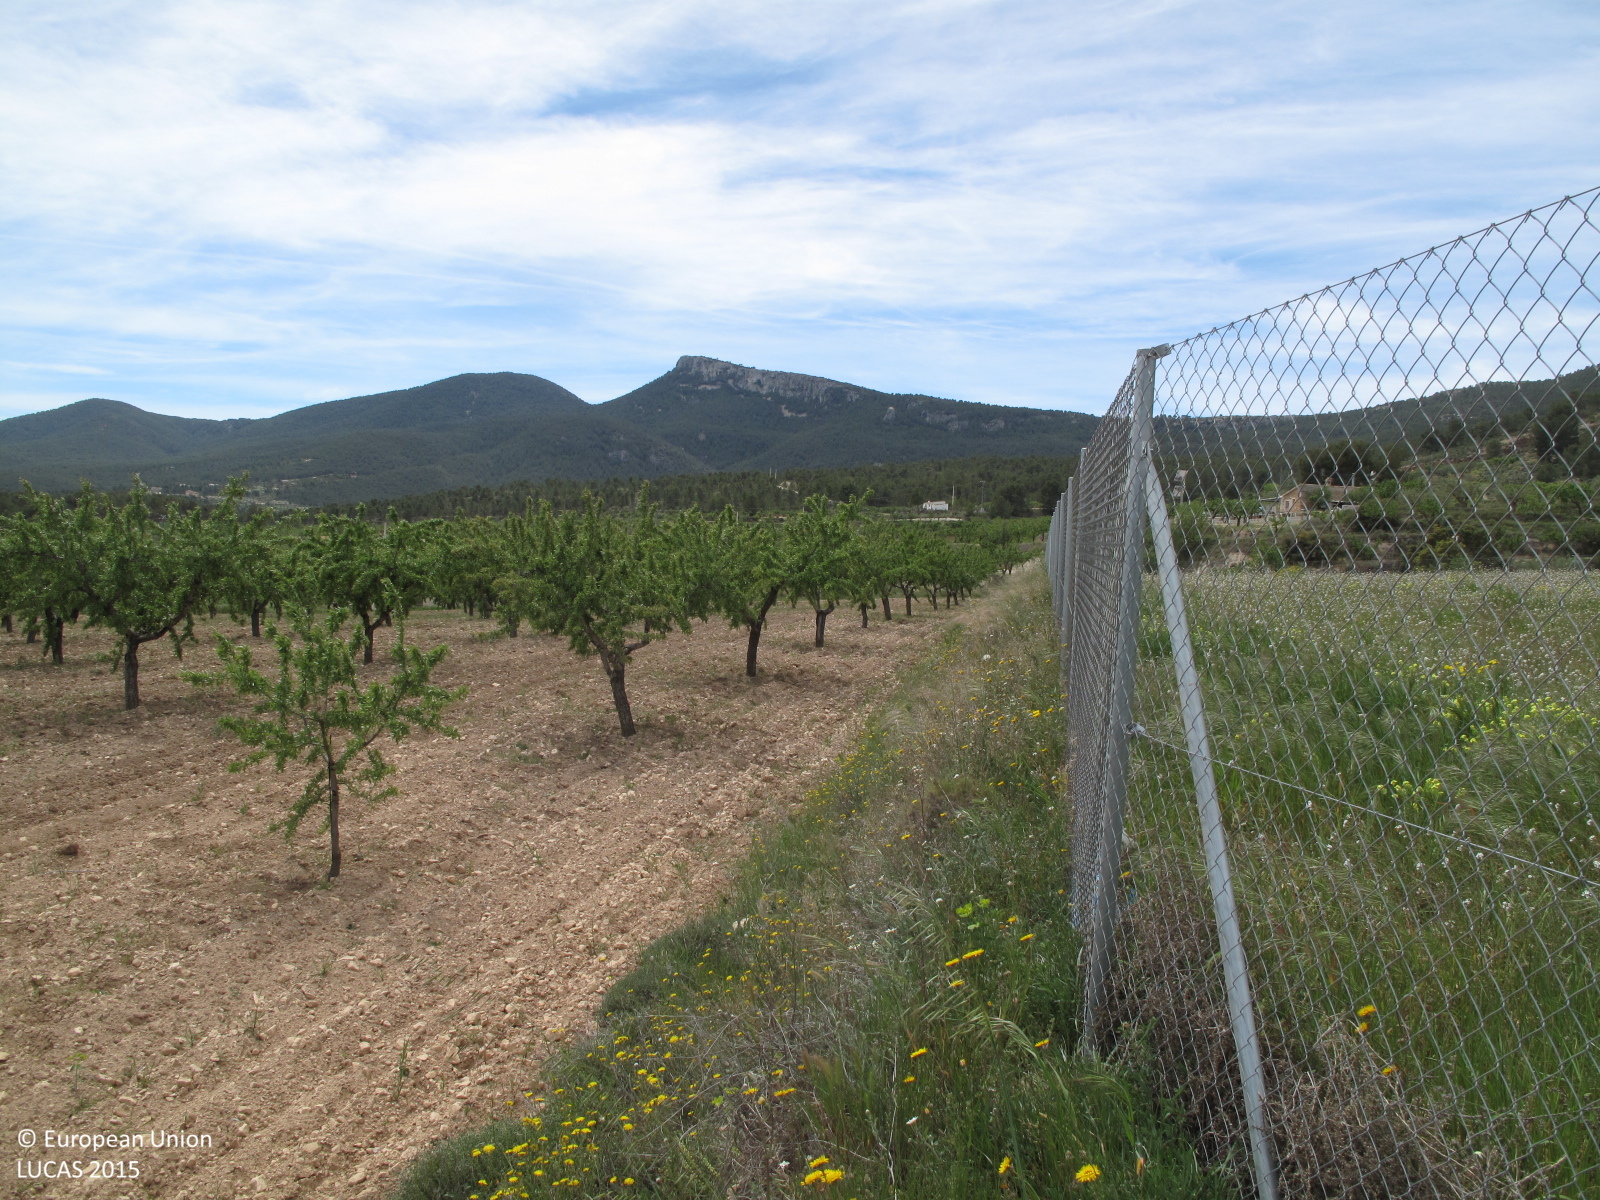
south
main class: Cropland
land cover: Olive groves
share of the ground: < 10 %
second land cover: Spontaneously vegetated surfaces
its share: > 75 %
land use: Agriculture (excluding fallow land and kitchen gardens)
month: April
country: ES
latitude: 38.5701
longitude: -0.6743
